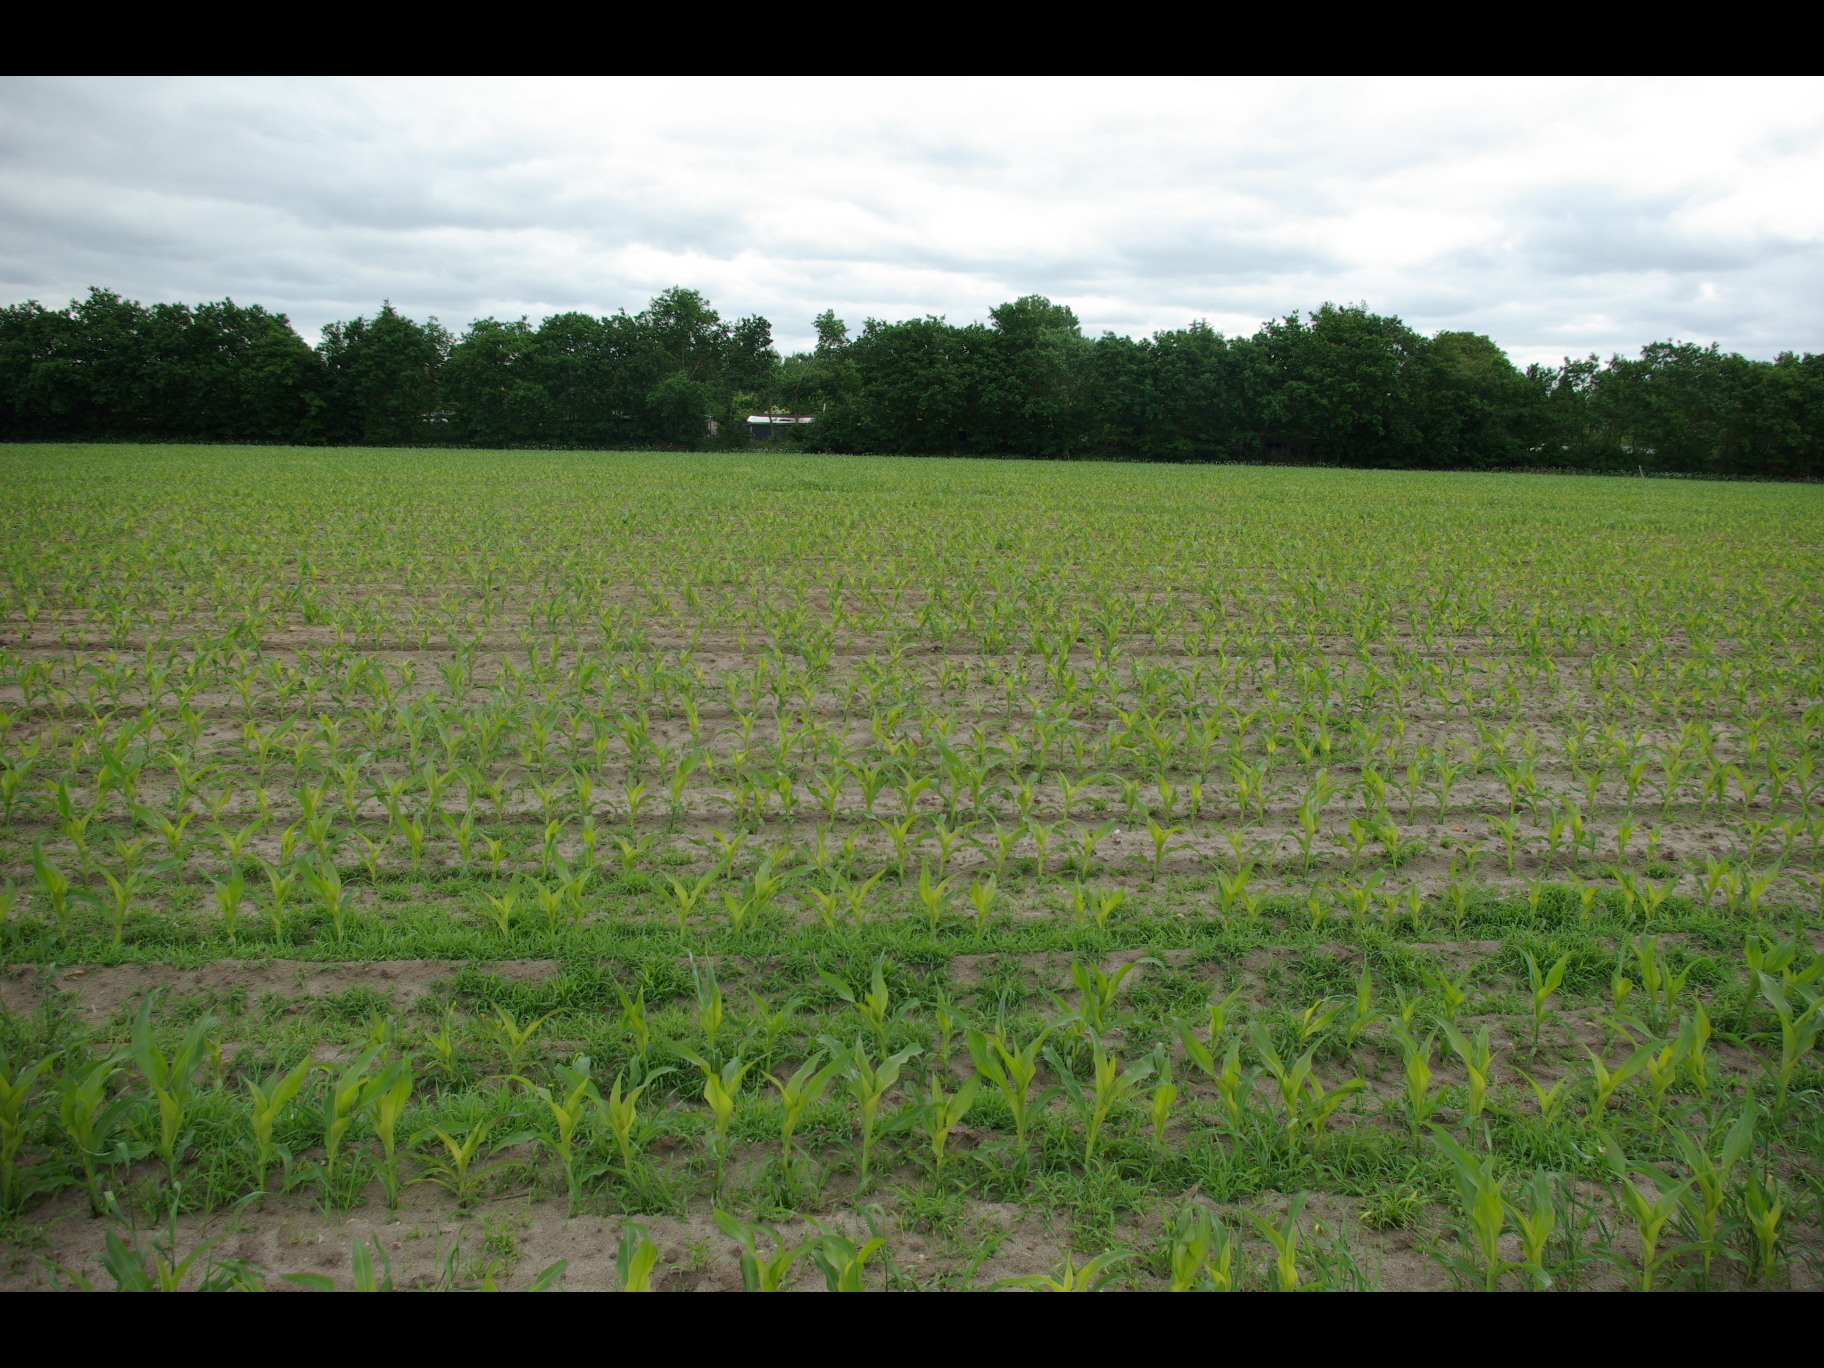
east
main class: Cropland
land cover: Maize
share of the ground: 25 - 50 %
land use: Agriculture (excluding fallow land and kitchen gardens)
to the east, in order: Maize; Broadleaved woodland; Artificial constructions in urban areas
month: June
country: DE
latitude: 54.0669
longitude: 9.9236
